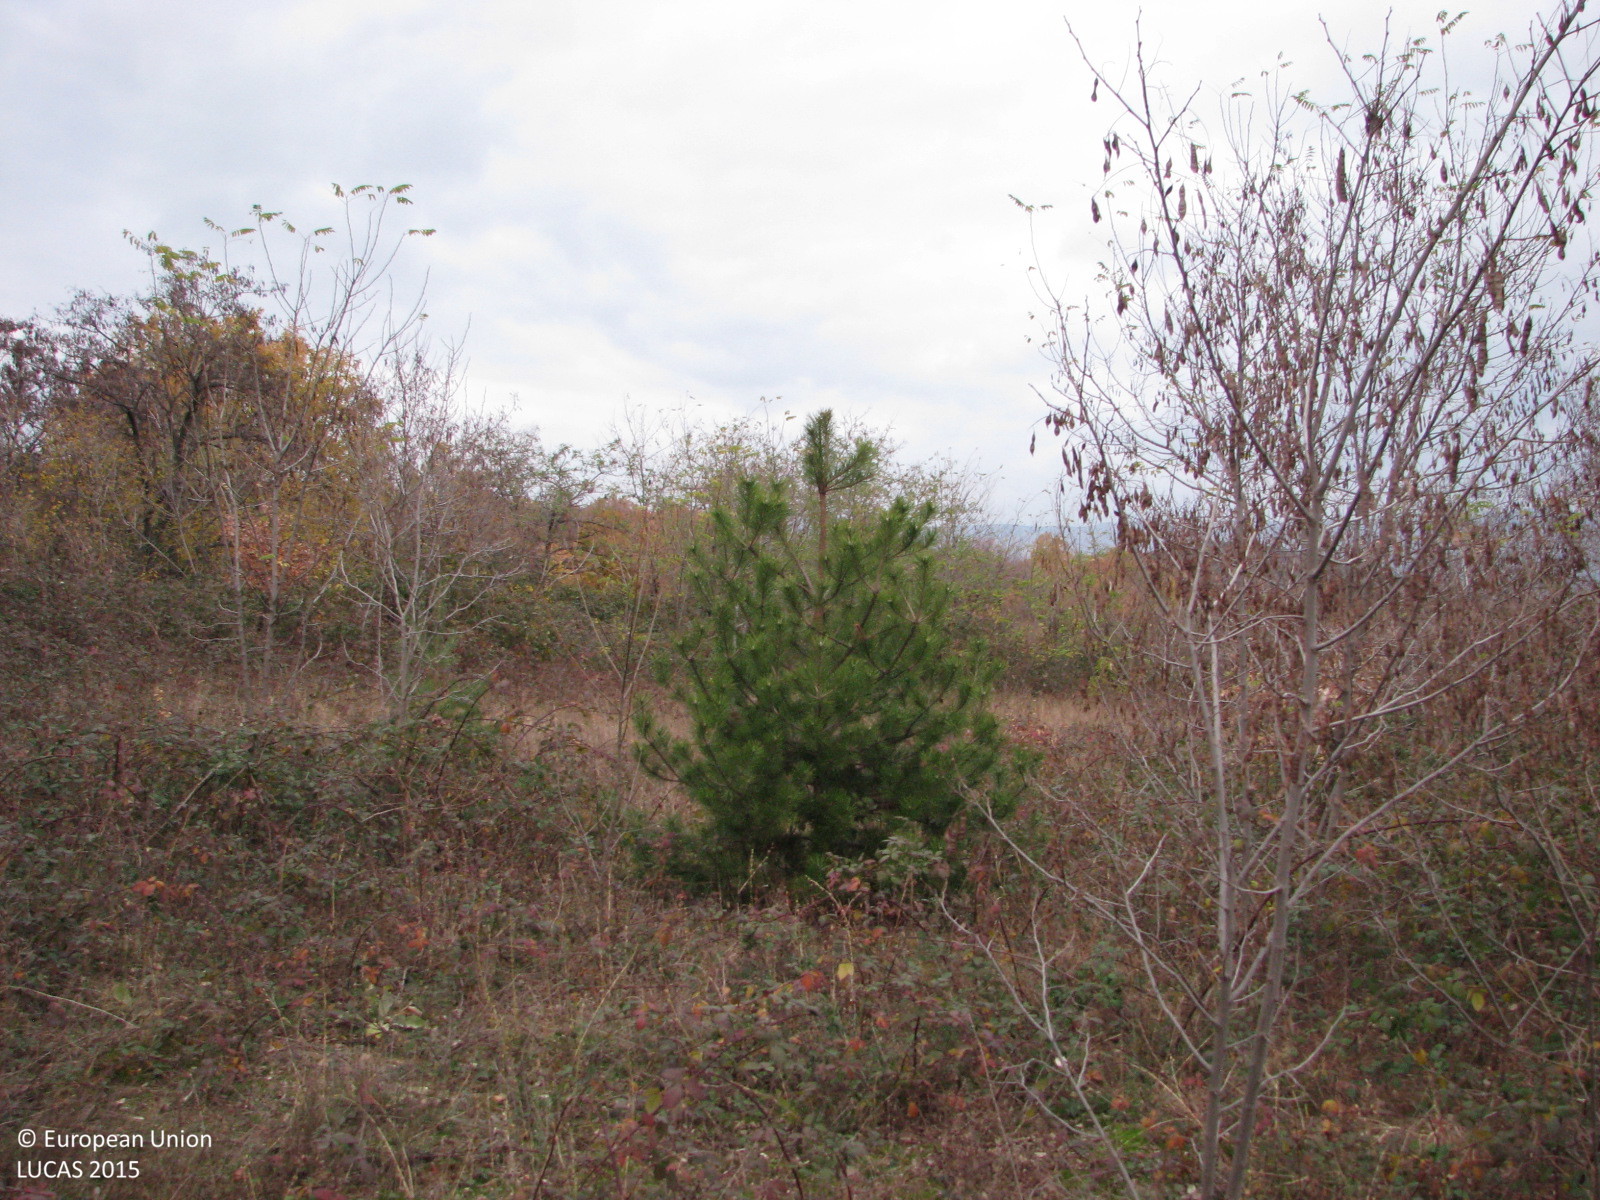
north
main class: Shrubland
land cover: Shrubland with sparse tree cover
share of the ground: > 75 %
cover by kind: shrubs 75 %, herbaceous plants 20 %, broadleaved forest trees 5 %
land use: Fallow land
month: December
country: BG
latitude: 42.3236
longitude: 24.0816
